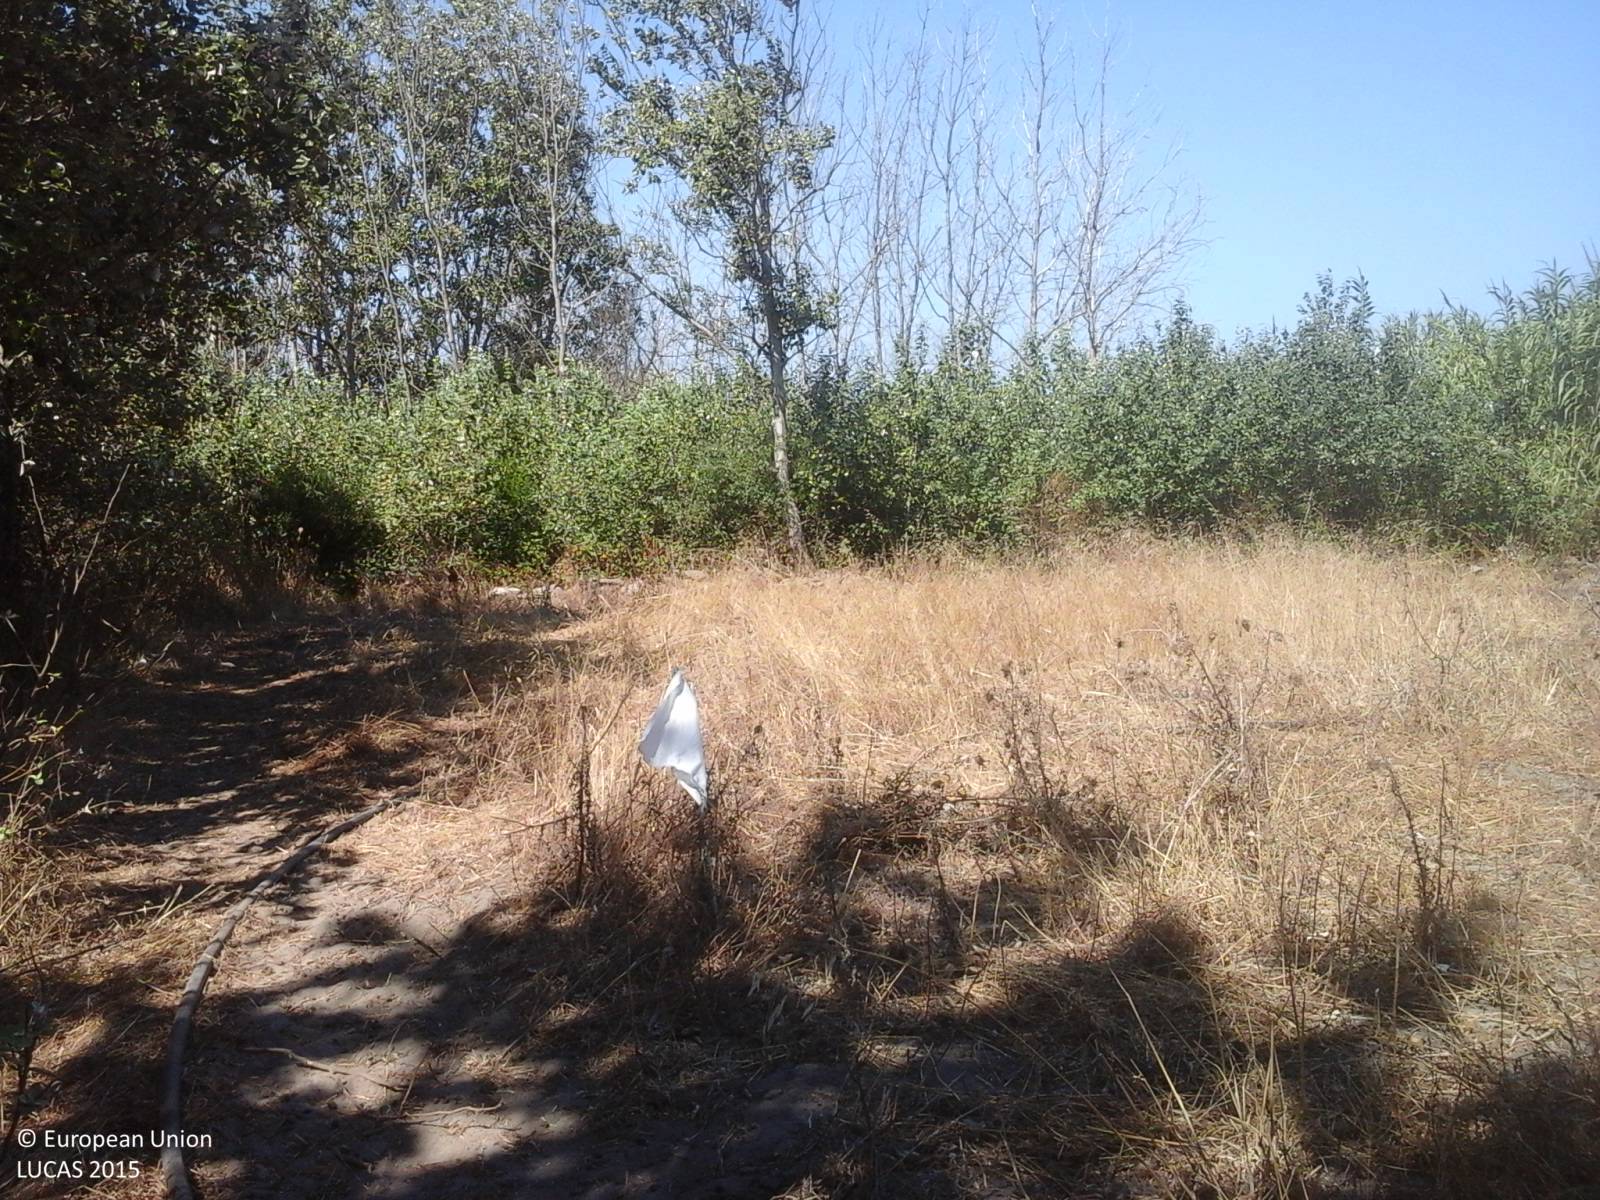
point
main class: Grassland
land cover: Spontaneously vegetated surfaces
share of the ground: > 75 %
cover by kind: herbaceous plants 85 %, unconsolidated bare surface 15 %
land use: Fallow land
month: July
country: IT
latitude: 39.2217
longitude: 8.3998
